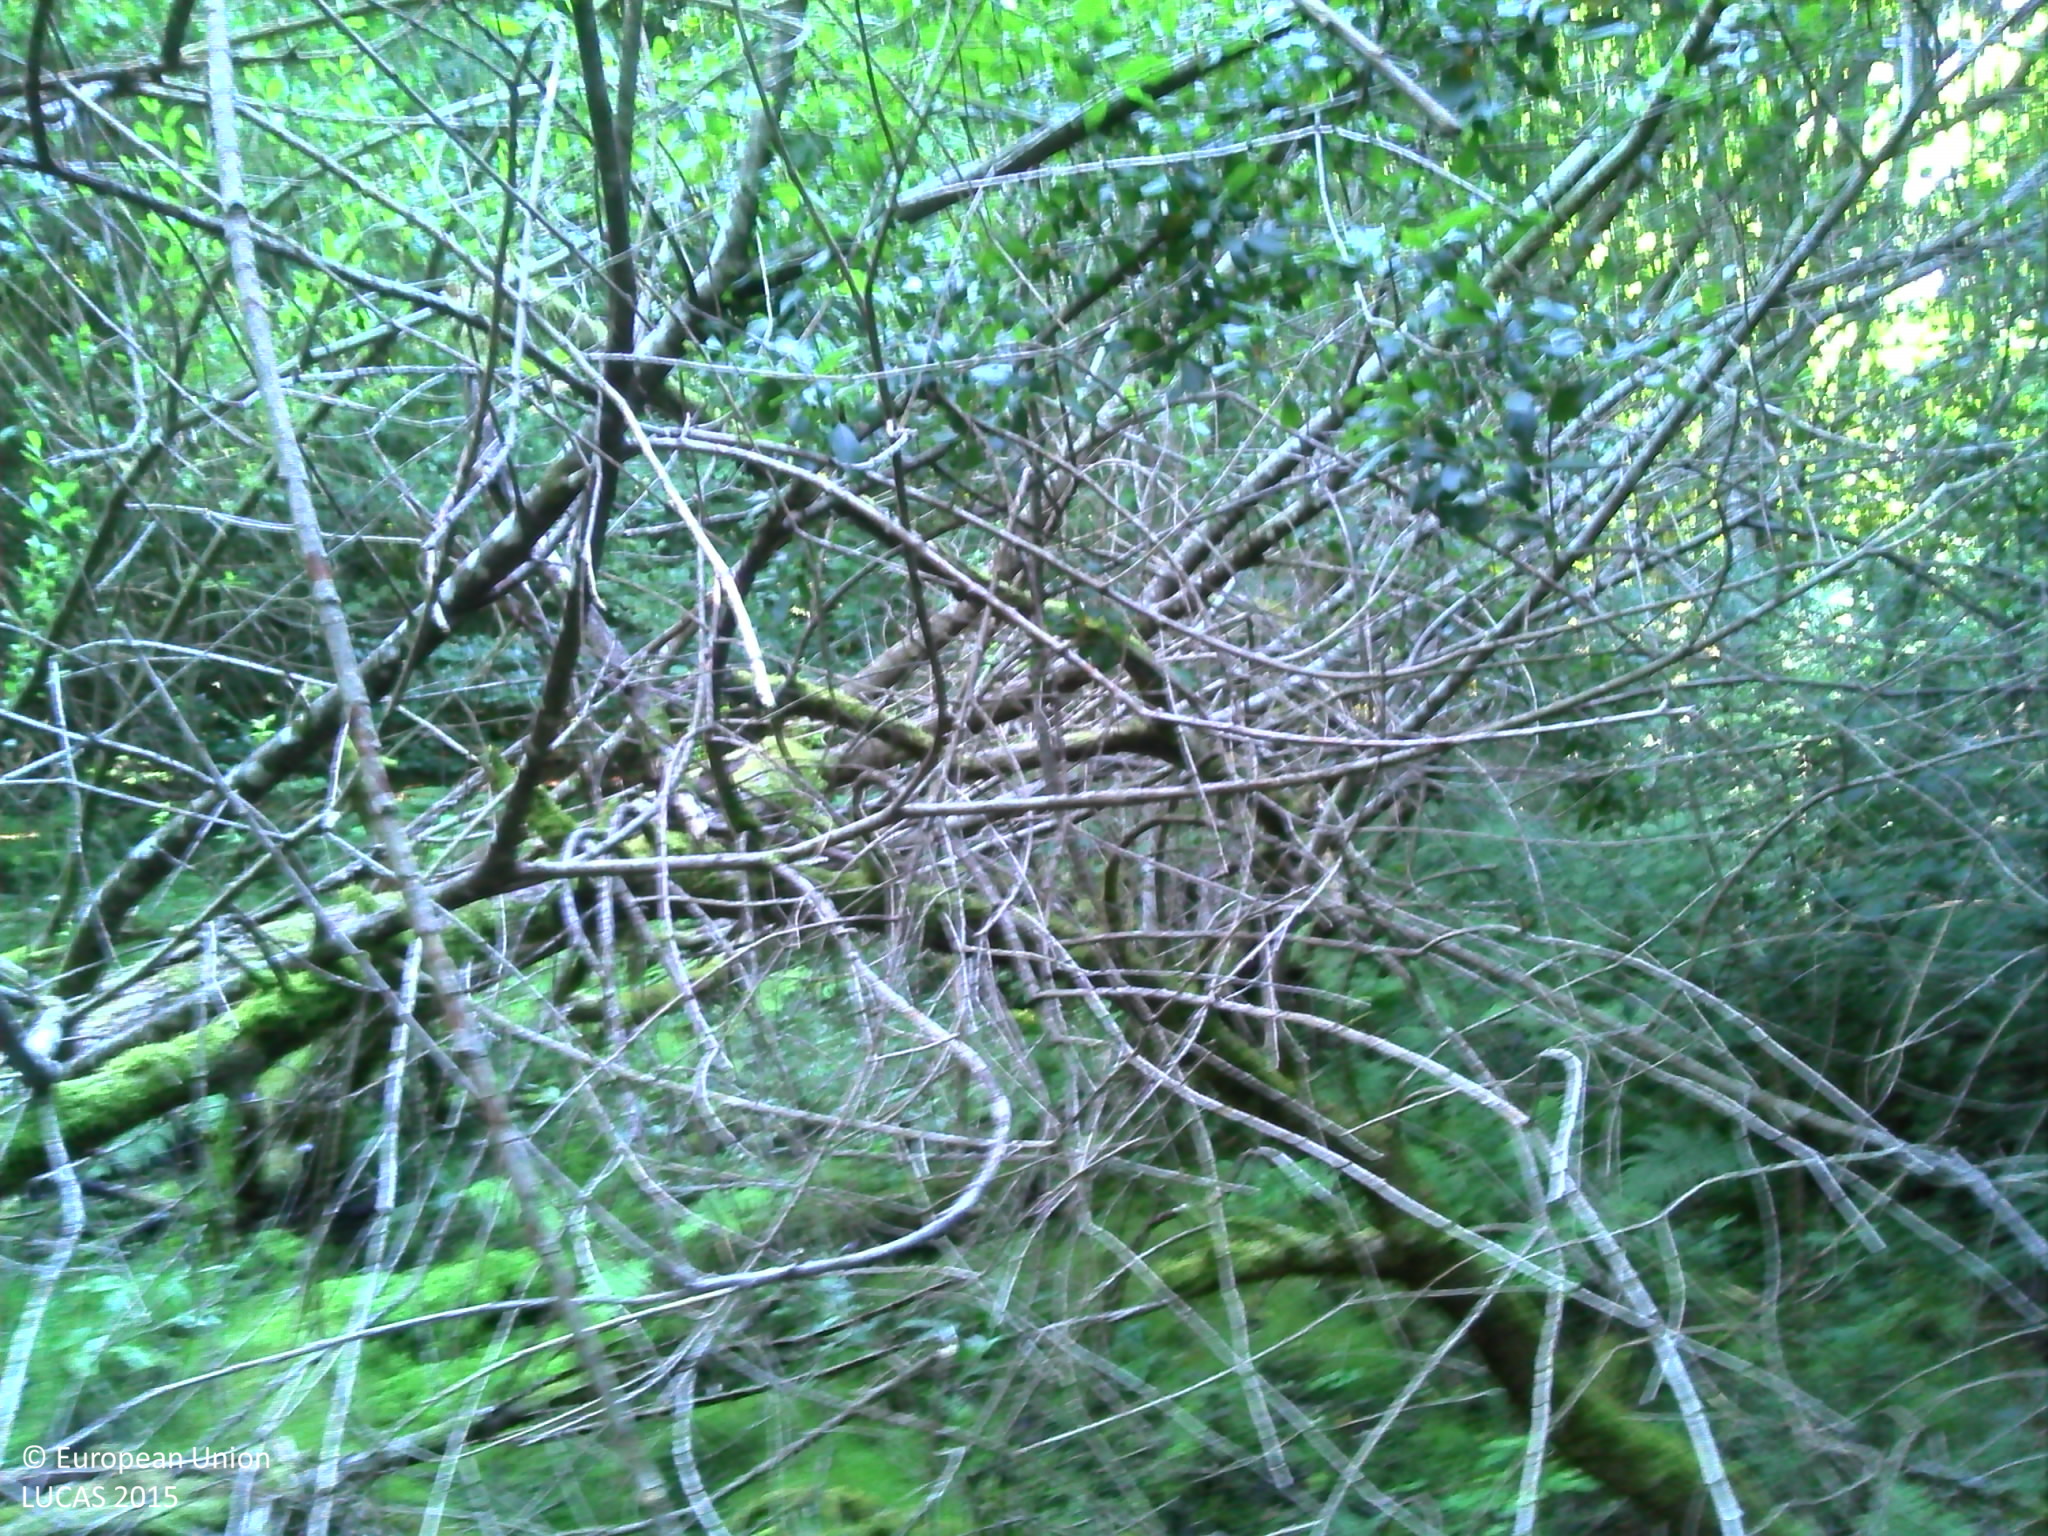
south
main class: Woodland
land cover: Broadleaved woodland
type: acidophilous oak and oak-birch forest
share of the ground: > 75 %
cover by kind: broadleaved forest trees 70 %, shrubs 10 %, herbaceous plants 10 %, lichens and mosses 10 %
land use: Forestry
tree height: > 5 m
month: August
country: FR
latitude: 45.8363
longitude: 1.7928
